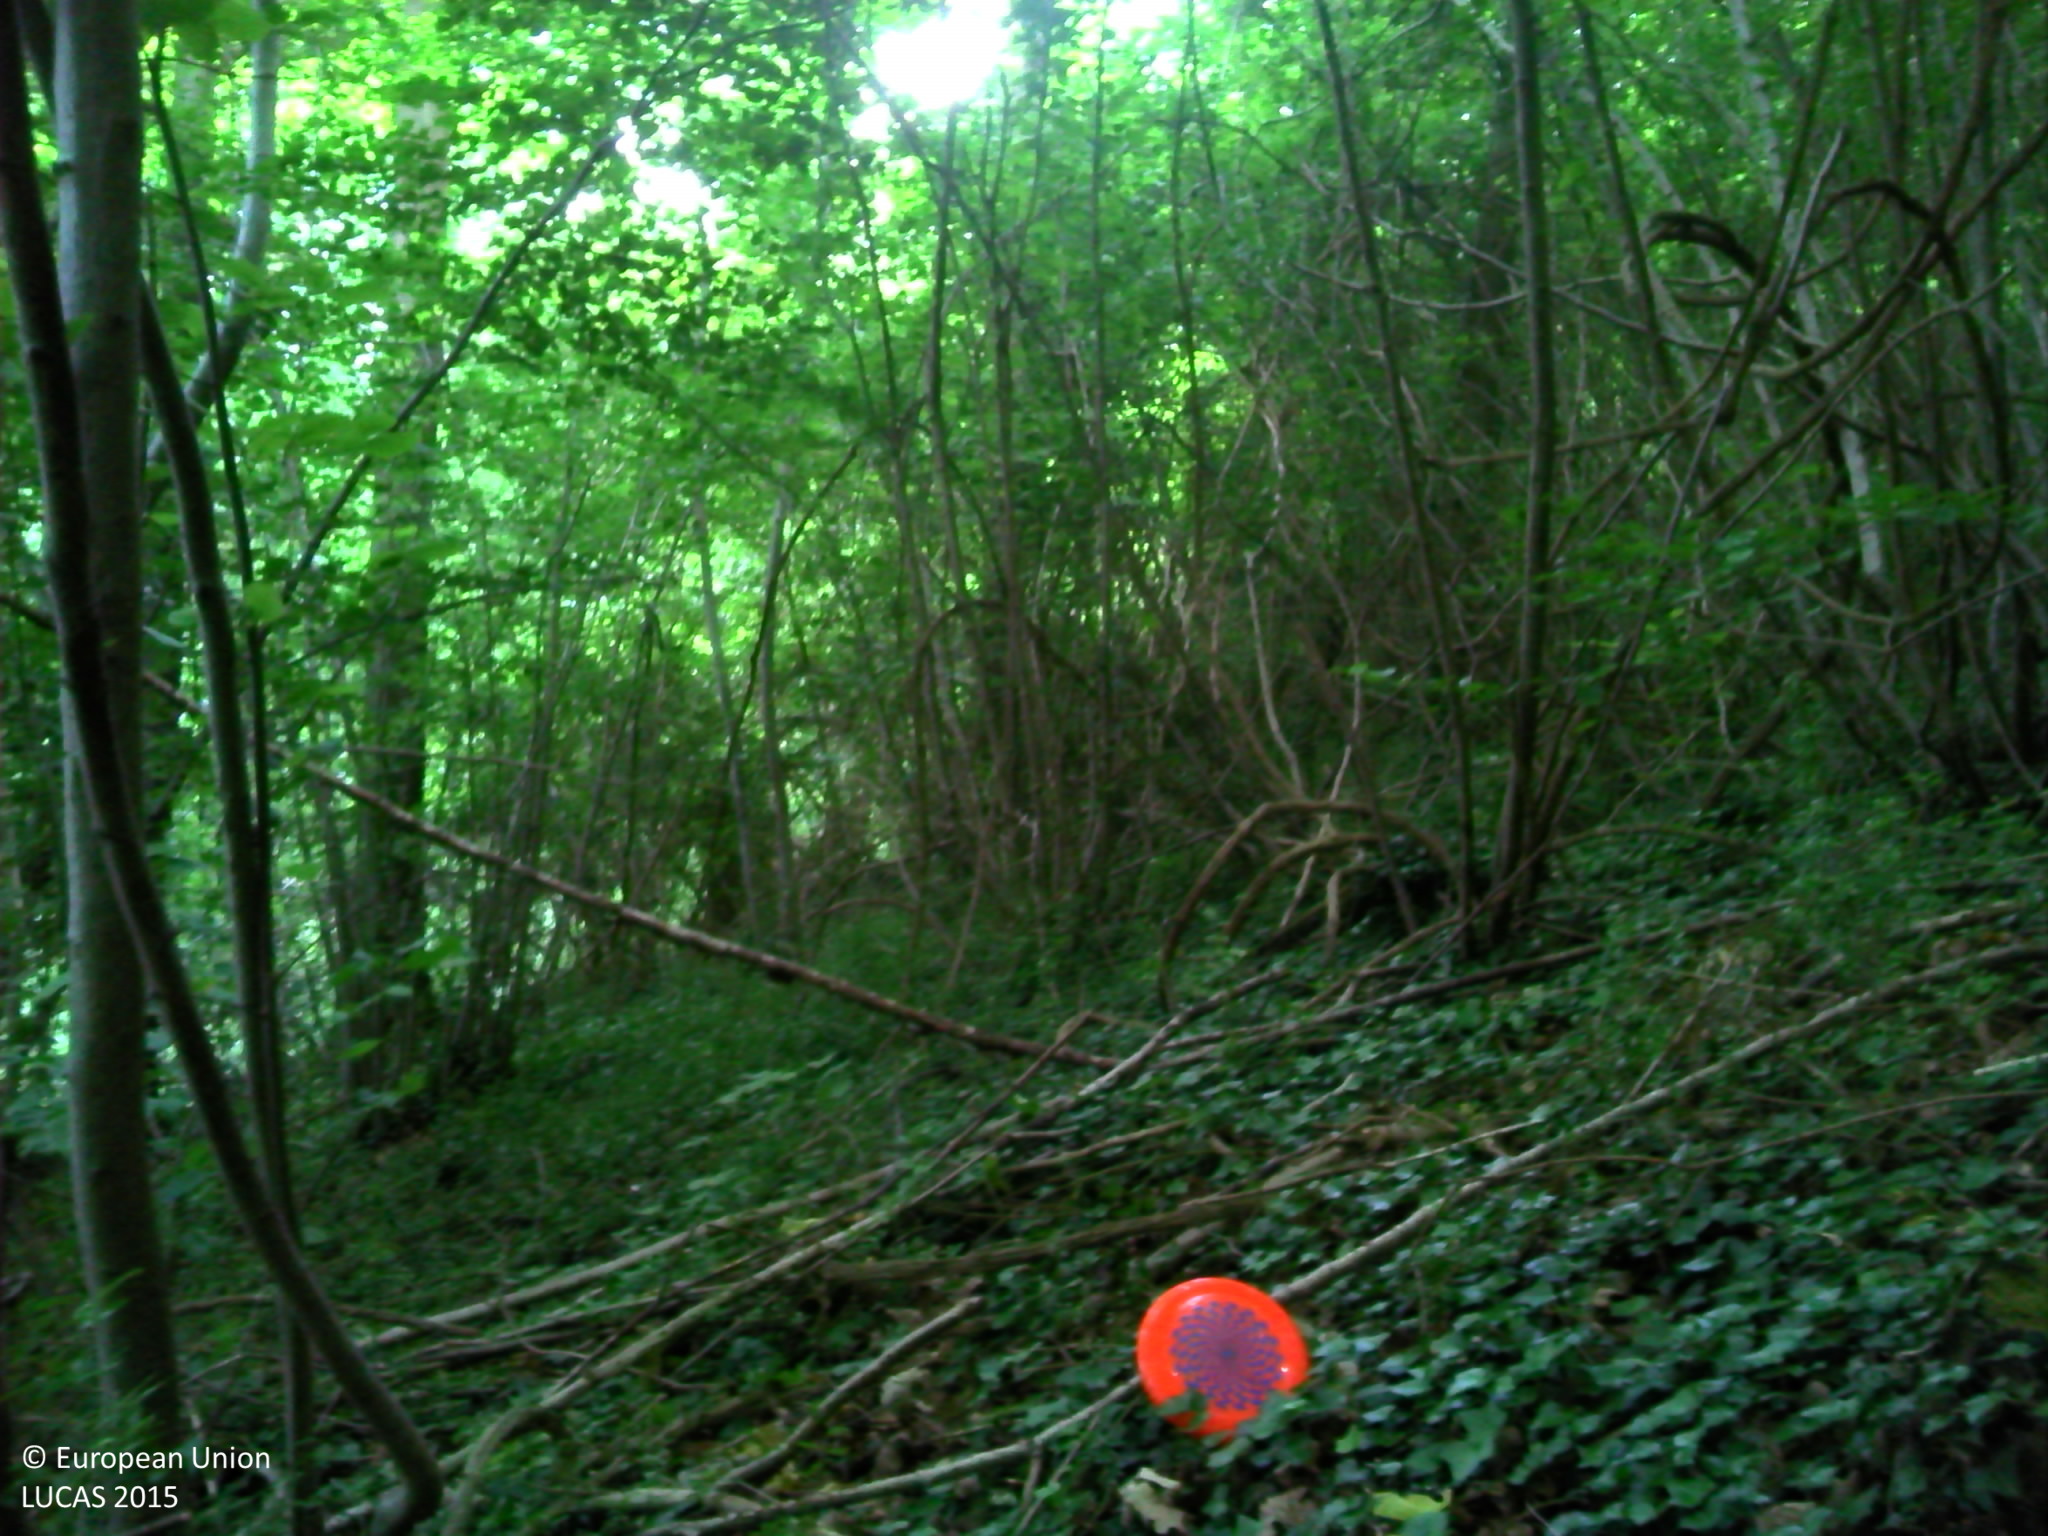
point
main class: Woodland
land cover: Broadleaved woodland
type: mesophytic deciduous forest
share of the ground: > 75 %
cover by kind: broadleaved forest trees 85 %, shrubs 10 %, lichens and mosses 5 %
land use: Forestry
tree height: > 5 m
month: June
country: FR
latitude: 49.5118
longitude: 2.9049
